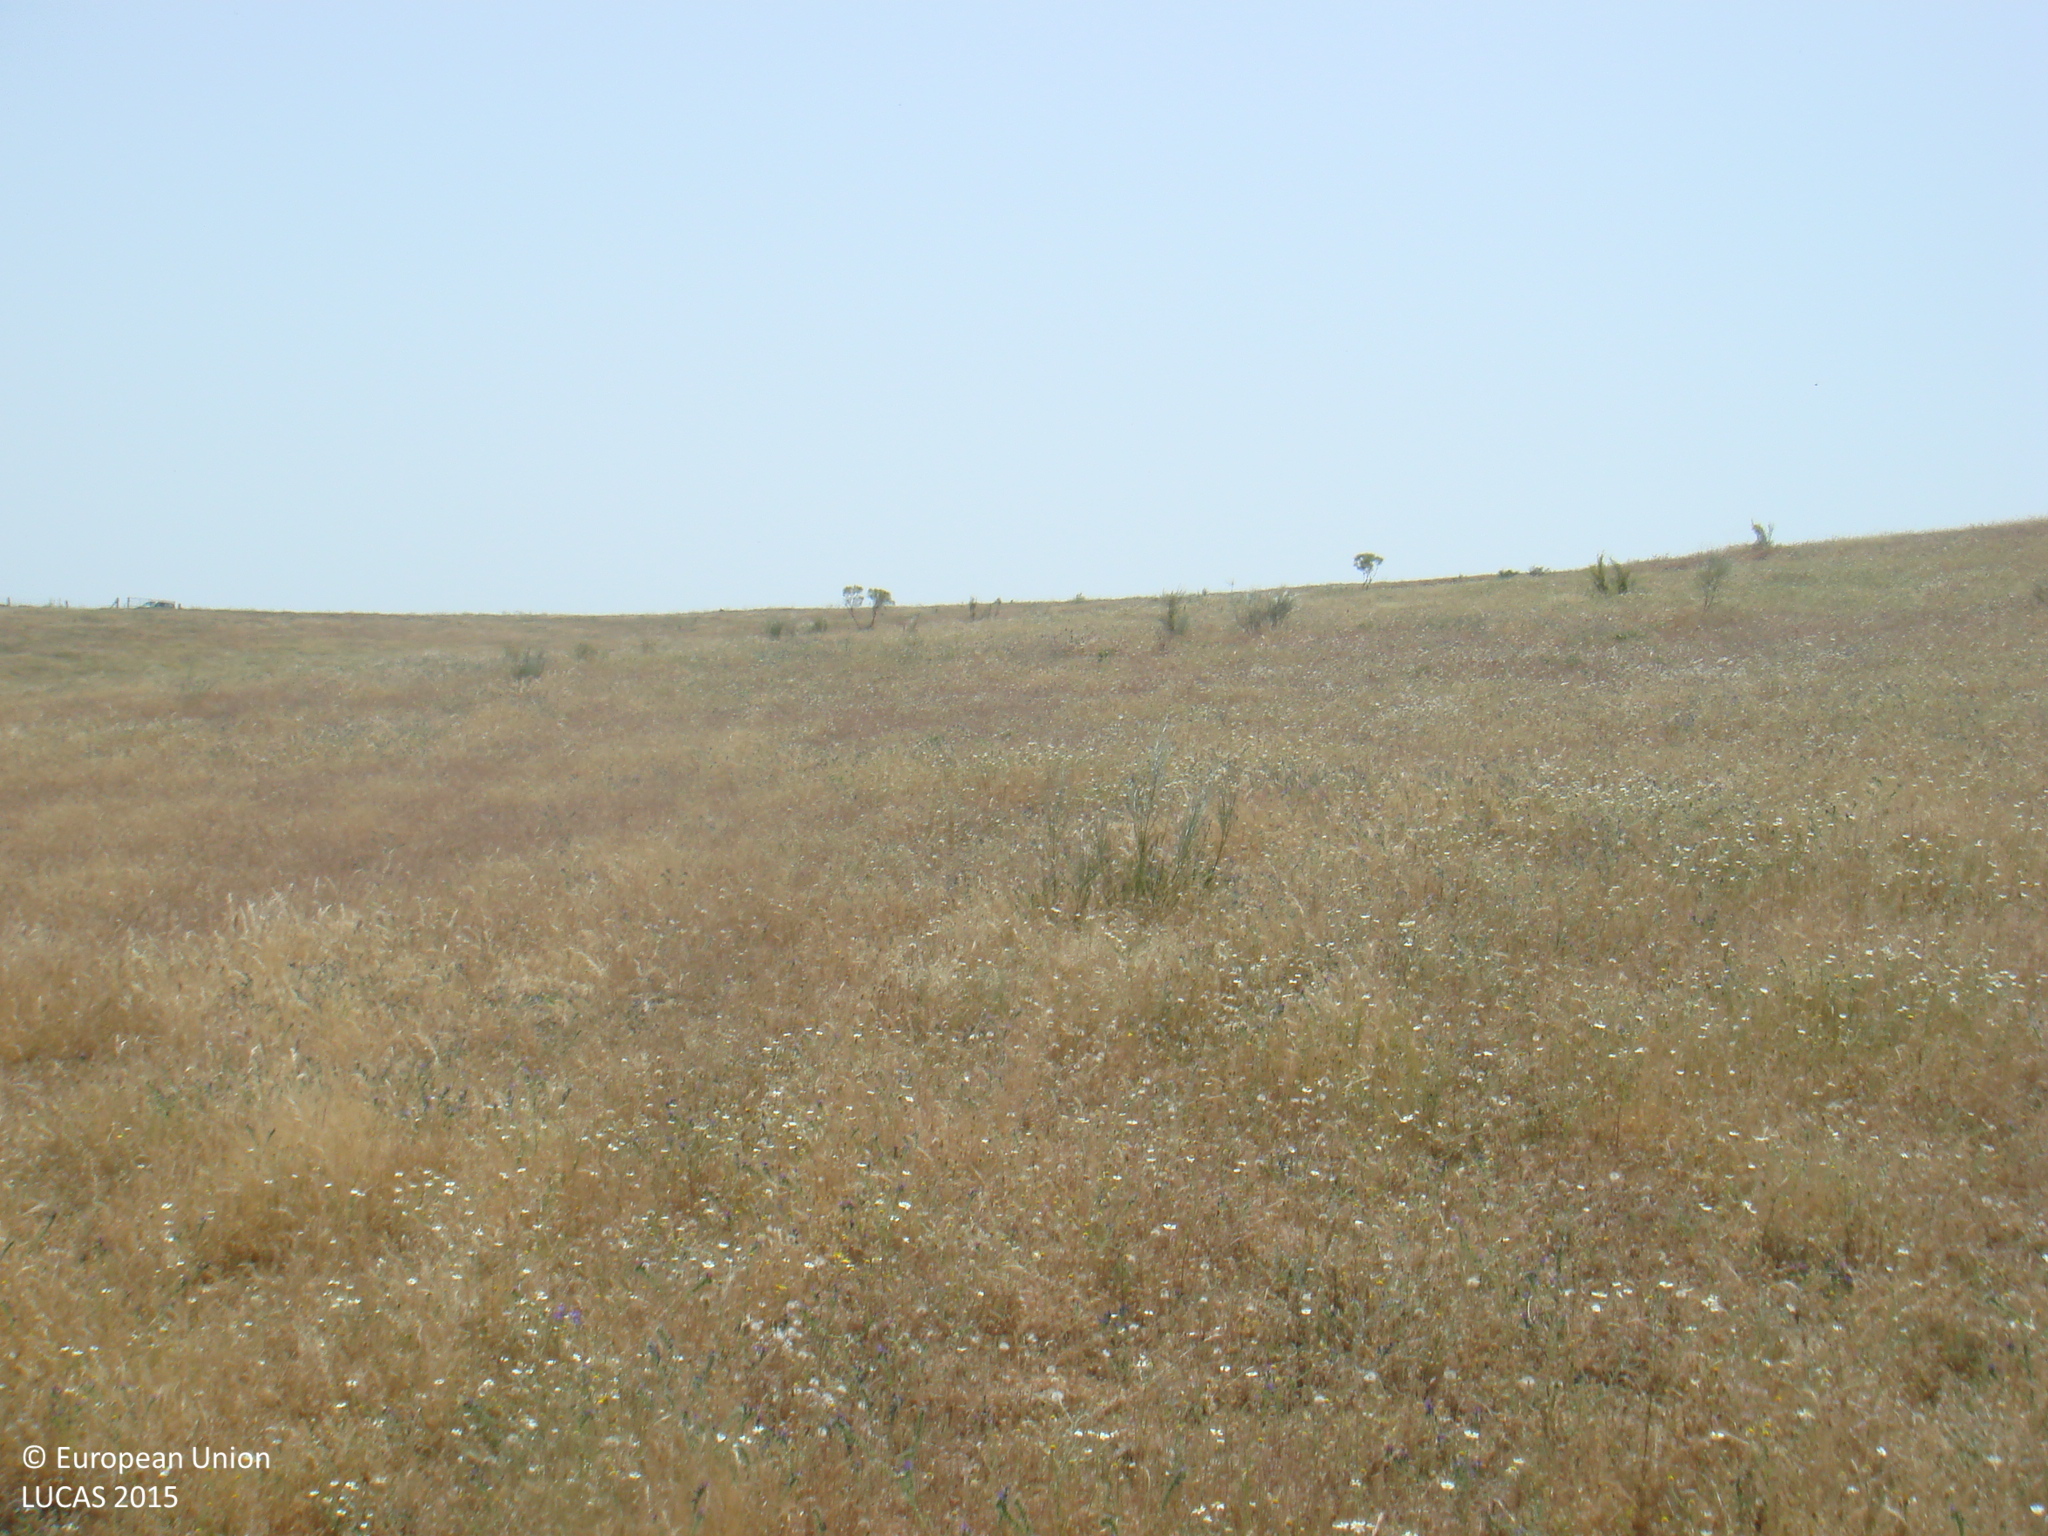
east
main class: Grassland
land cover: Grassland without tree/shrub cover
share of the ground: > 75 %
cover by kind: herbaceous plants 100 %
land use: Agriculture (excluding fallow land and kitchen gardens)
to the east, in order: Grassland without tree/shrub cover; Fences; Grass margins; Tracks; Grass margins; Dry stone walls; Fences; Grassland without tree/shrub cover
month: May
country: ES
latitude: 38.4941
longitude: -4.6873
